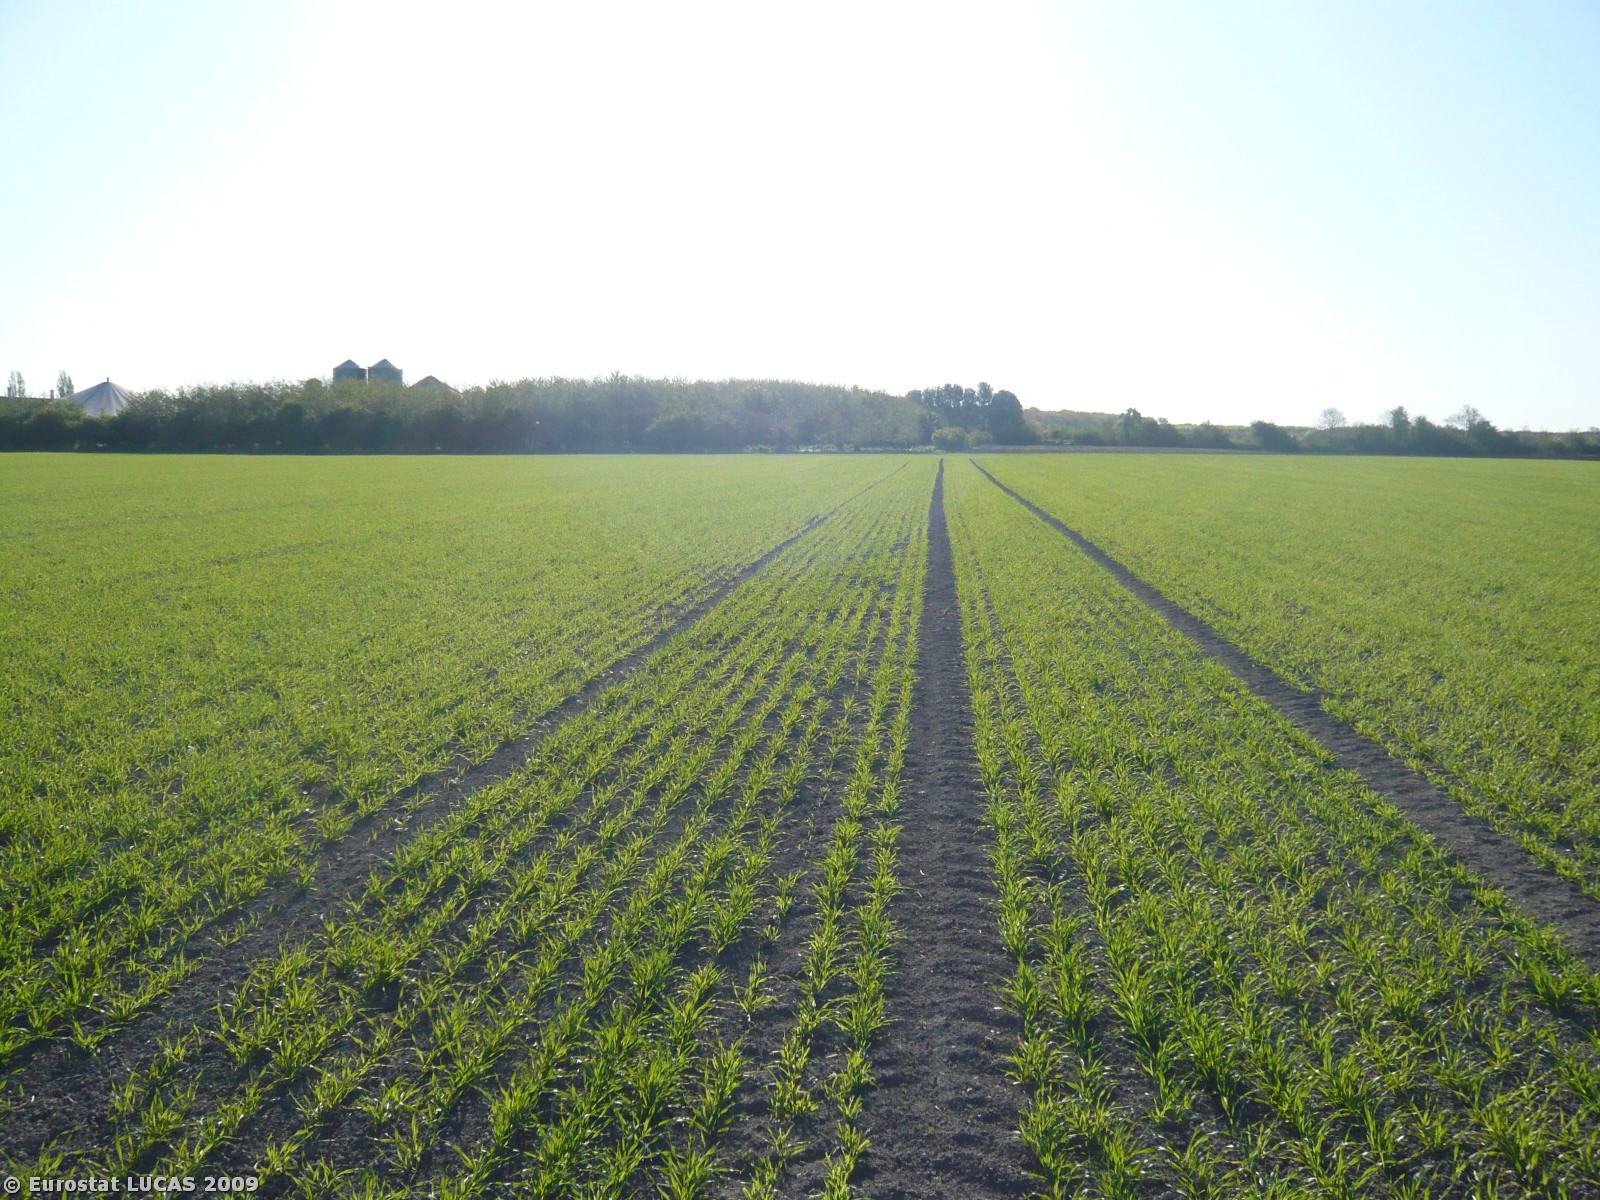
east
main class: Cropland
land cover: Common wheat
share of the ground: 25 - 50 %
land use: Agriculture (excluding fallow land and kitchen gardens)
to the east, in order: Common wheat; Bare land; Broadleaved woodland; Grassland without tree/shrub cover; Artificial constructions in urban areas
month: May
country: DK
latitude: 55.0910
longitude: 12.1451
